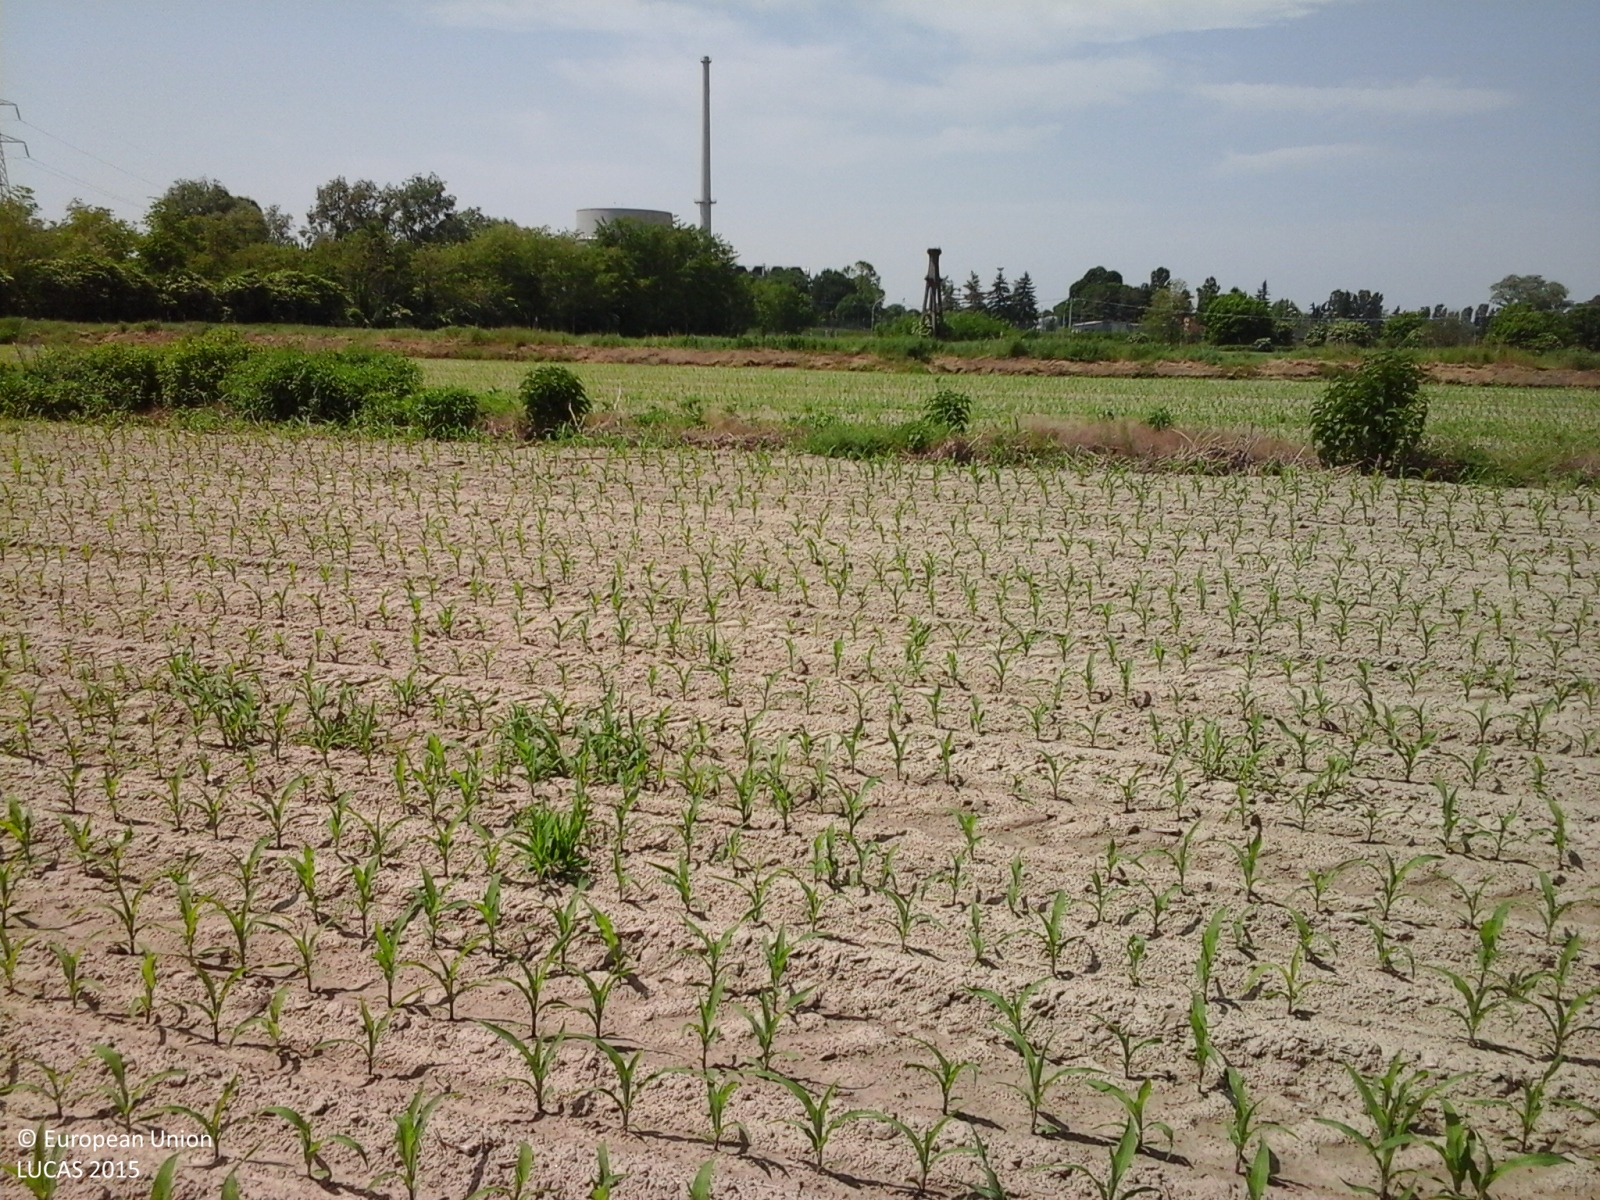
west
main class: Cropland
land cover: Maize
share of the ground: 10 - 25 %
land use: Agriculture (excluding fallow land and kitchen gardens)
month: May
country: IT
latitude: 45.1840
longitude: 8.2850
